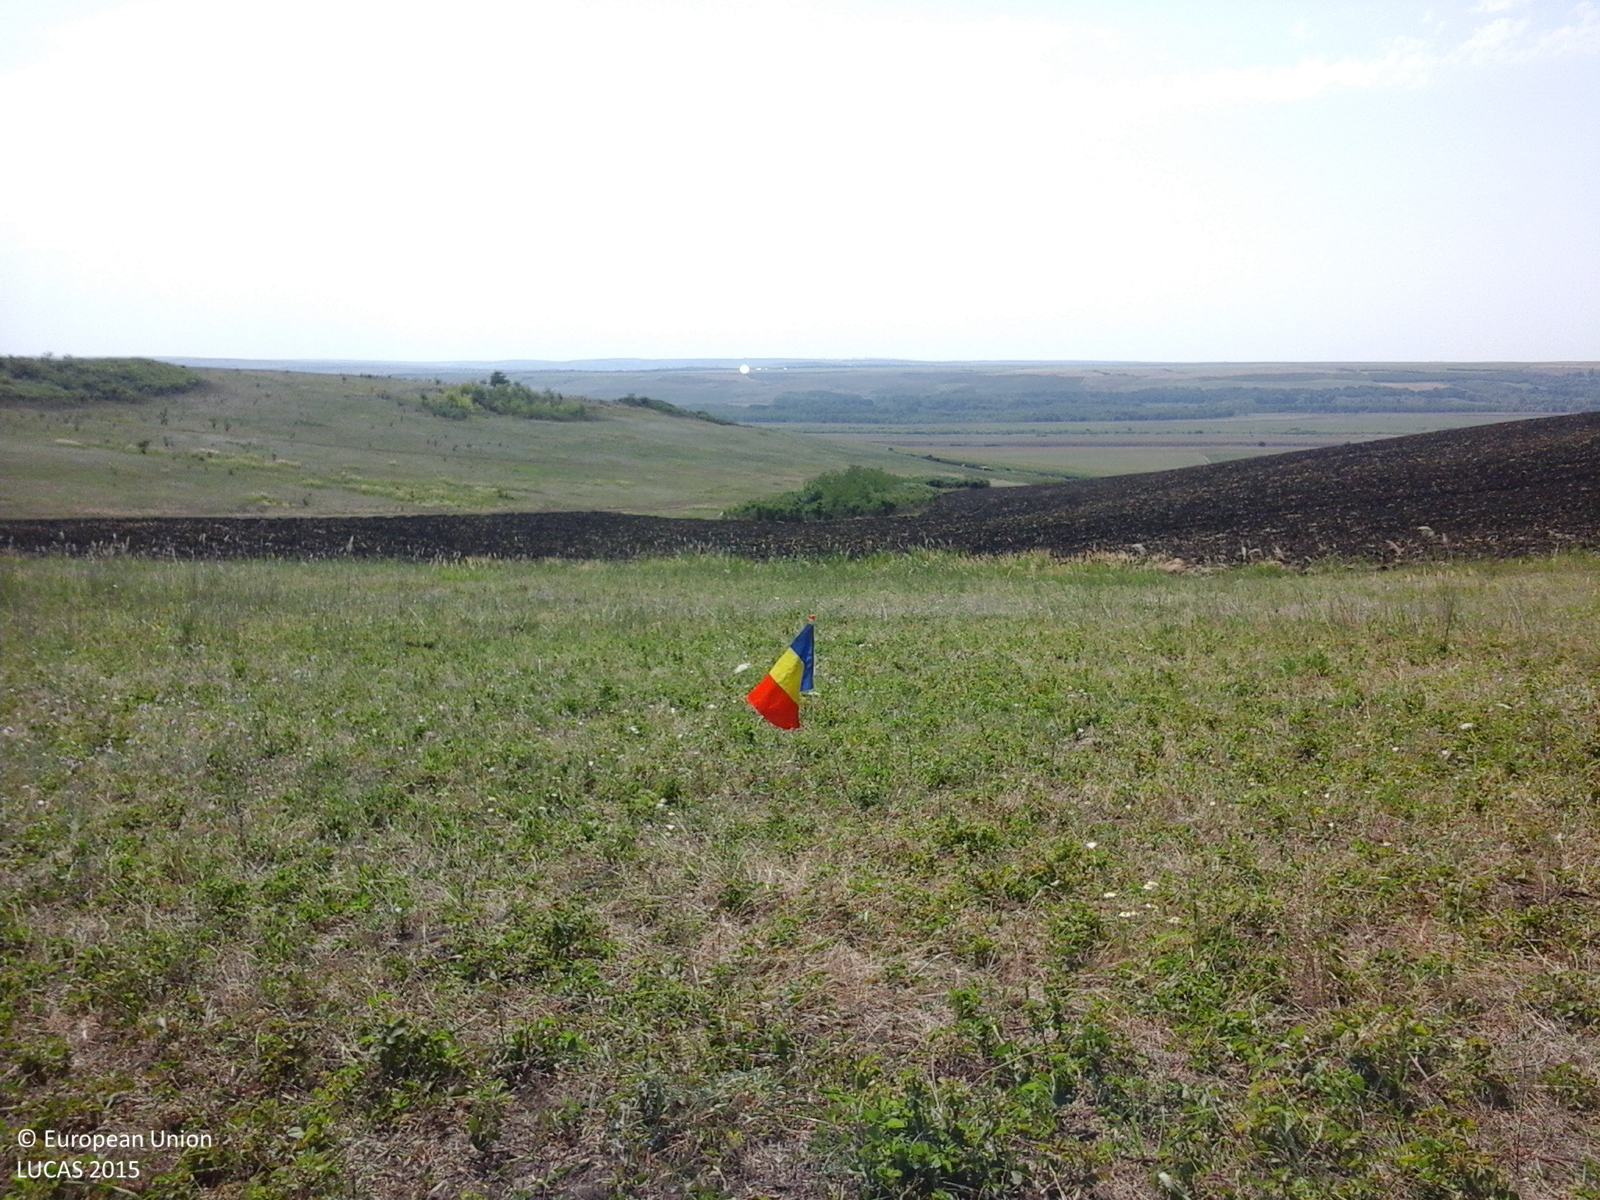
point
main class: Grassland
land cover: Grassland without tree/shrub cover
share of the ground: > 75 %
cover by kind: herbaceous plants 100 %
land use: Agriculture (excluding fallow land and kitchen gardens)
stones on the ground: < 10 %
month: July
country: RO
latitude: 46.1078
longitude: 27.5089
